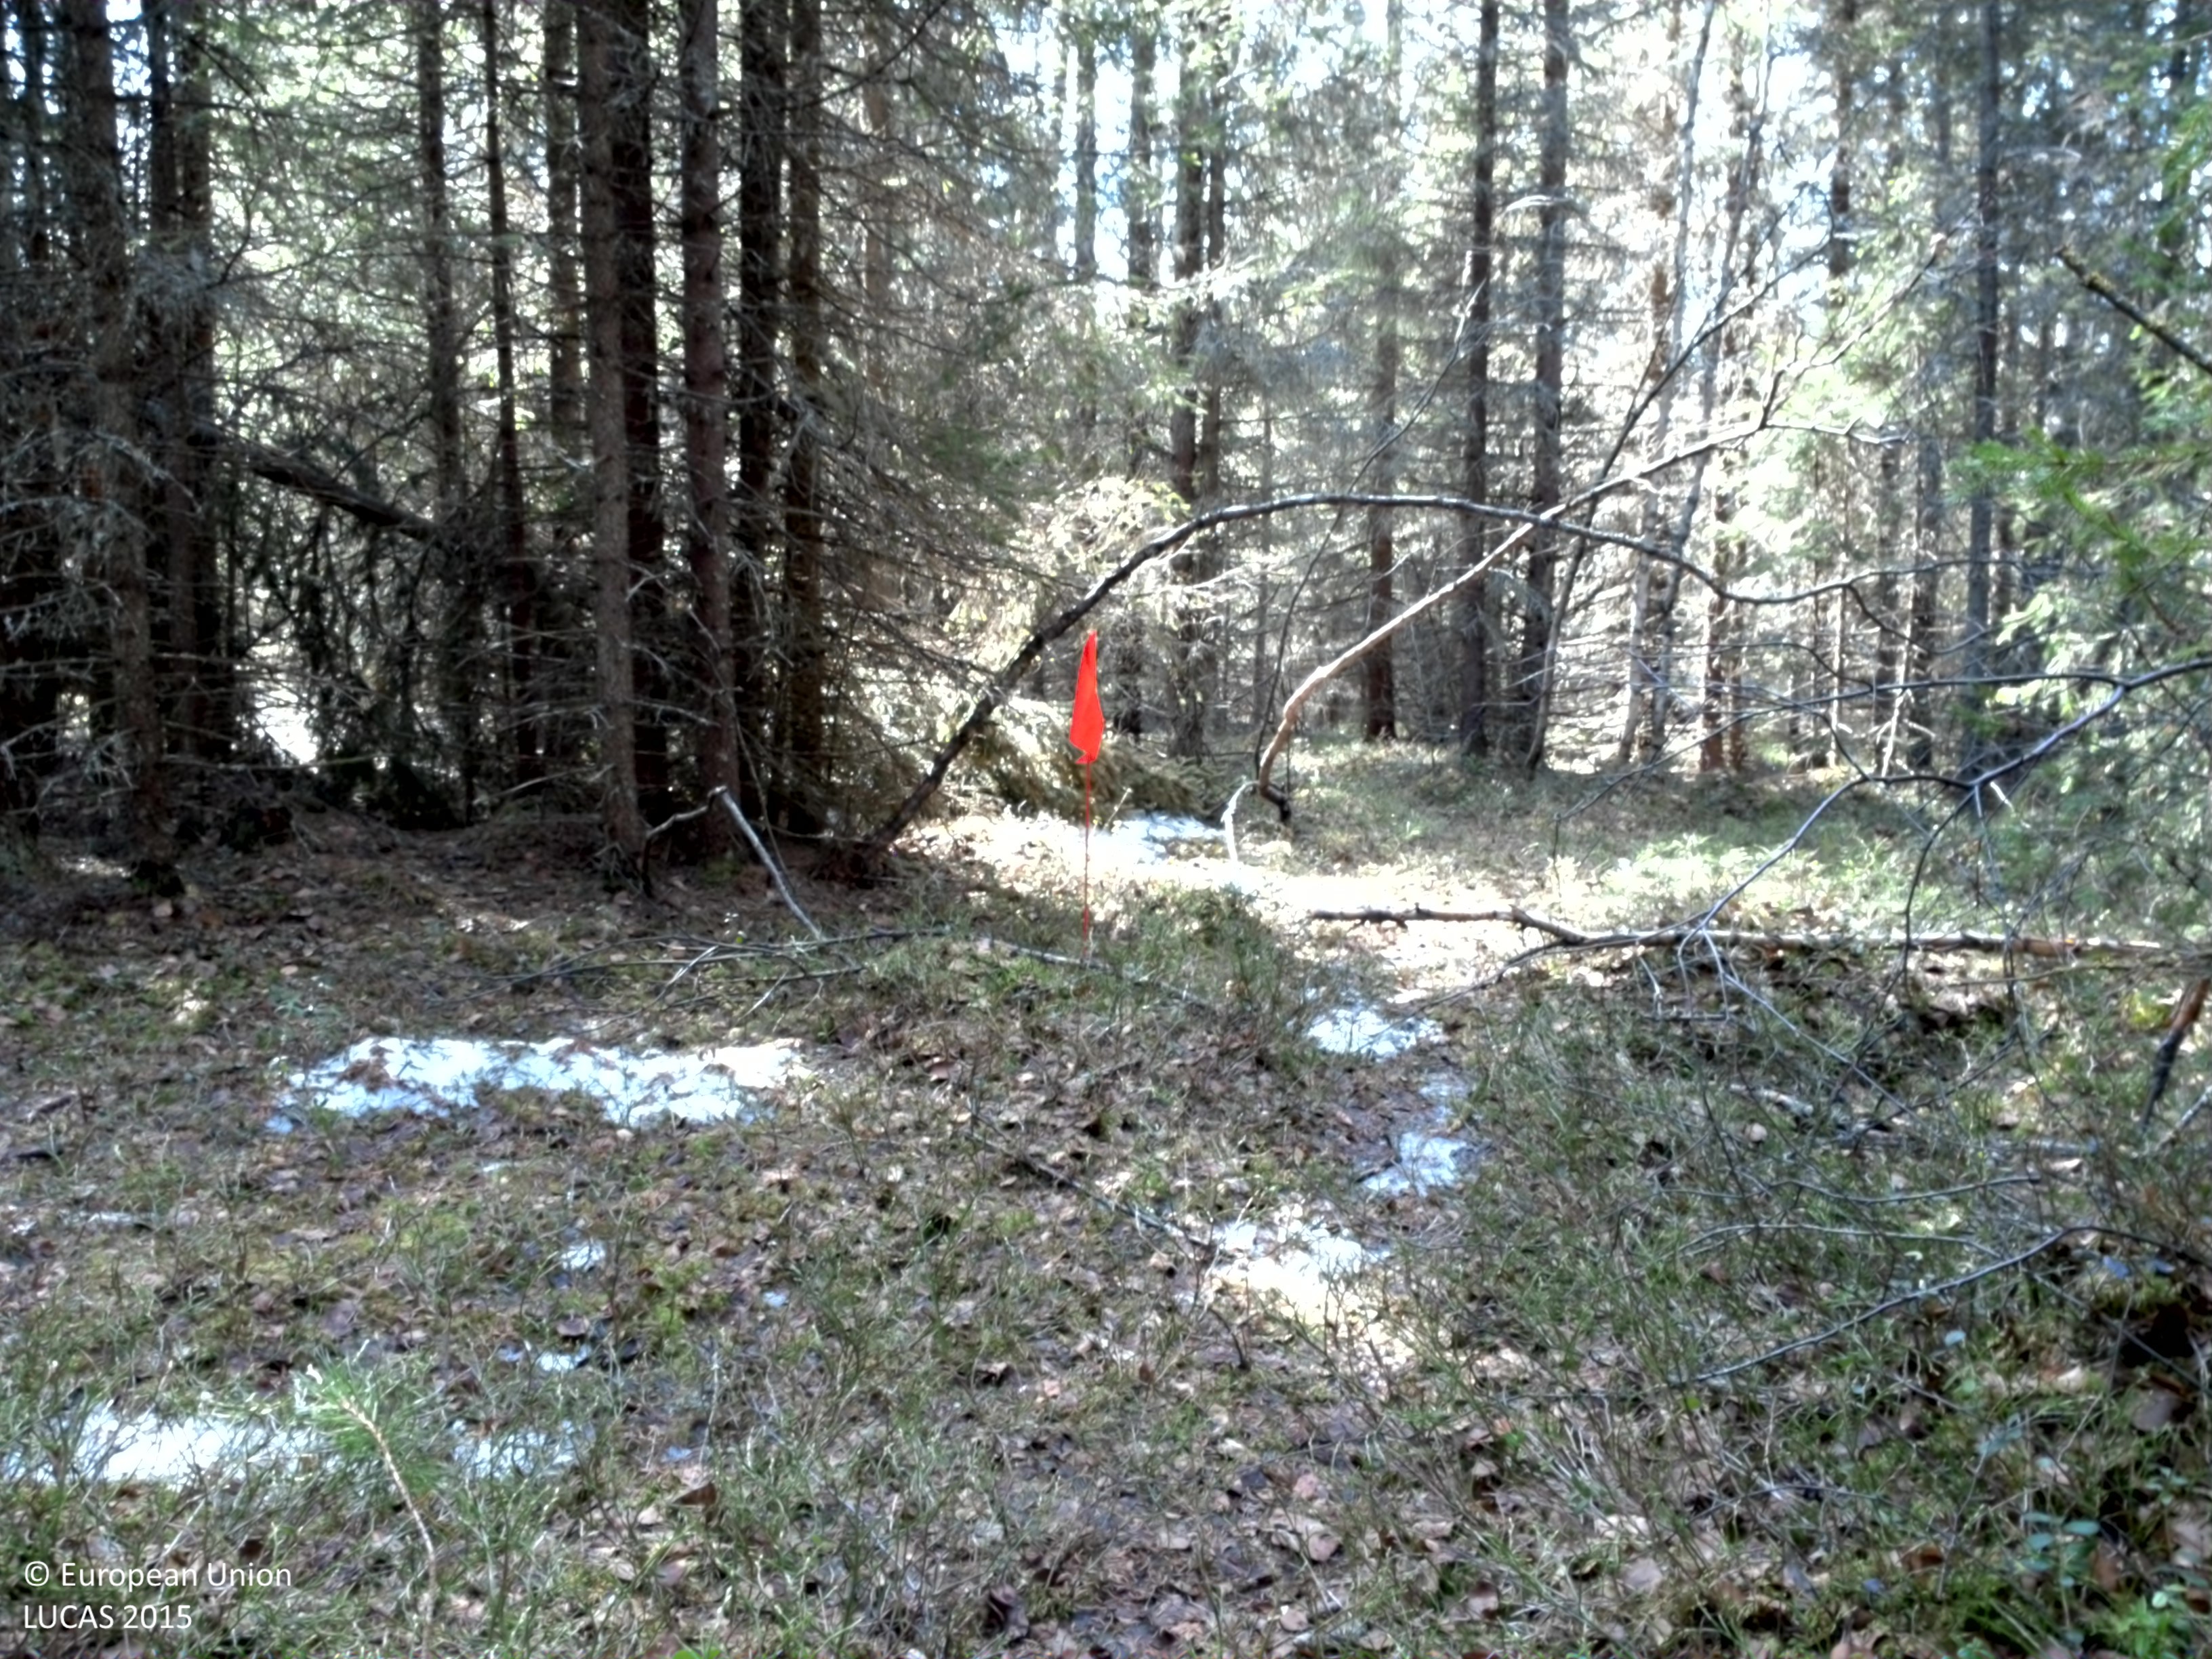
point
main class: Woodland
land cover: Spruce dominated coniferous woodland
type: boreal forest
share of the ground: > 75 %
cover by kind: coniferous forest trees 80 %, shrubs 10 %, broadleaved forest trees 5 %, lichens and mosses 5 %
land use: Forestry
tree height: > 5 m
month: May
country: SE
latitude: 65.7736
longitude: 23.2030
